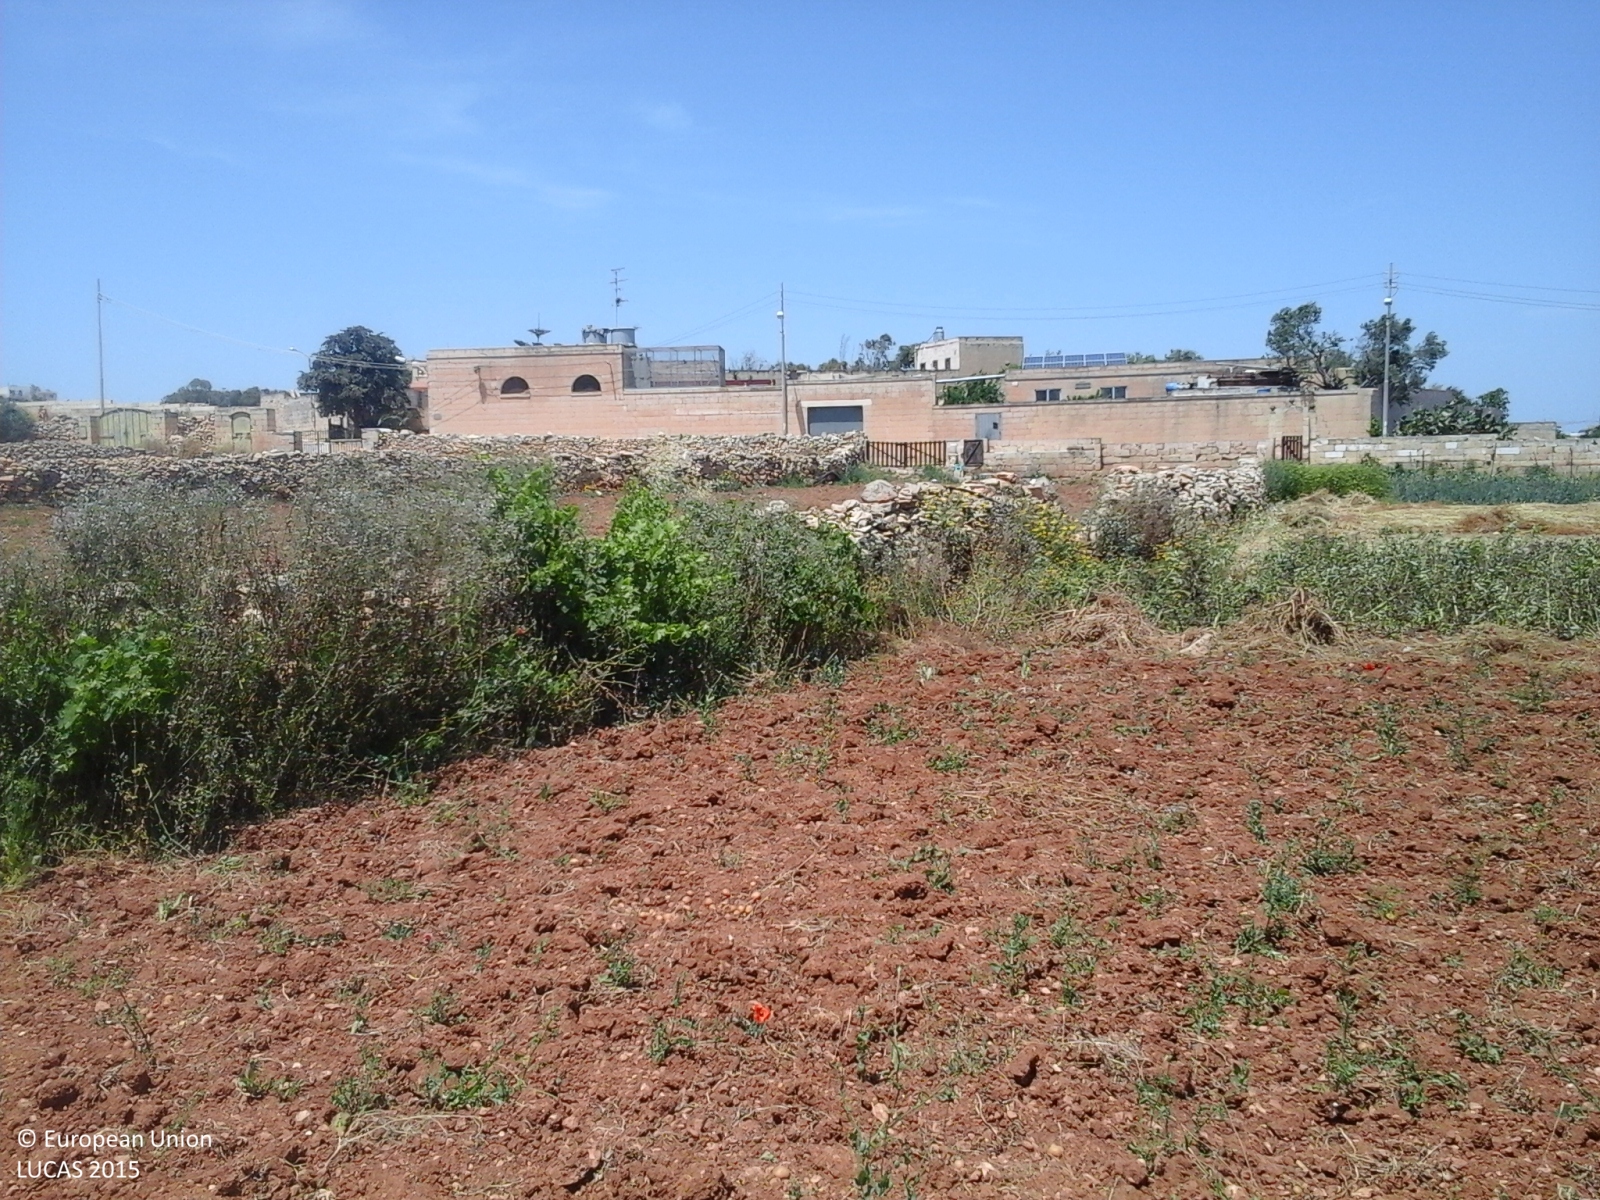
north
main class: Cropland
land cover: Olive groves
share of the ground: 10 - 25 %
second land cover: Spontaneously vegetated surfaces
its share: 10 - 25 %
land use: Agriculture (excluding fallow land and kitchen gardens)
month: May
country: MT
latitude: 35.8218
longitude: 14.4852
